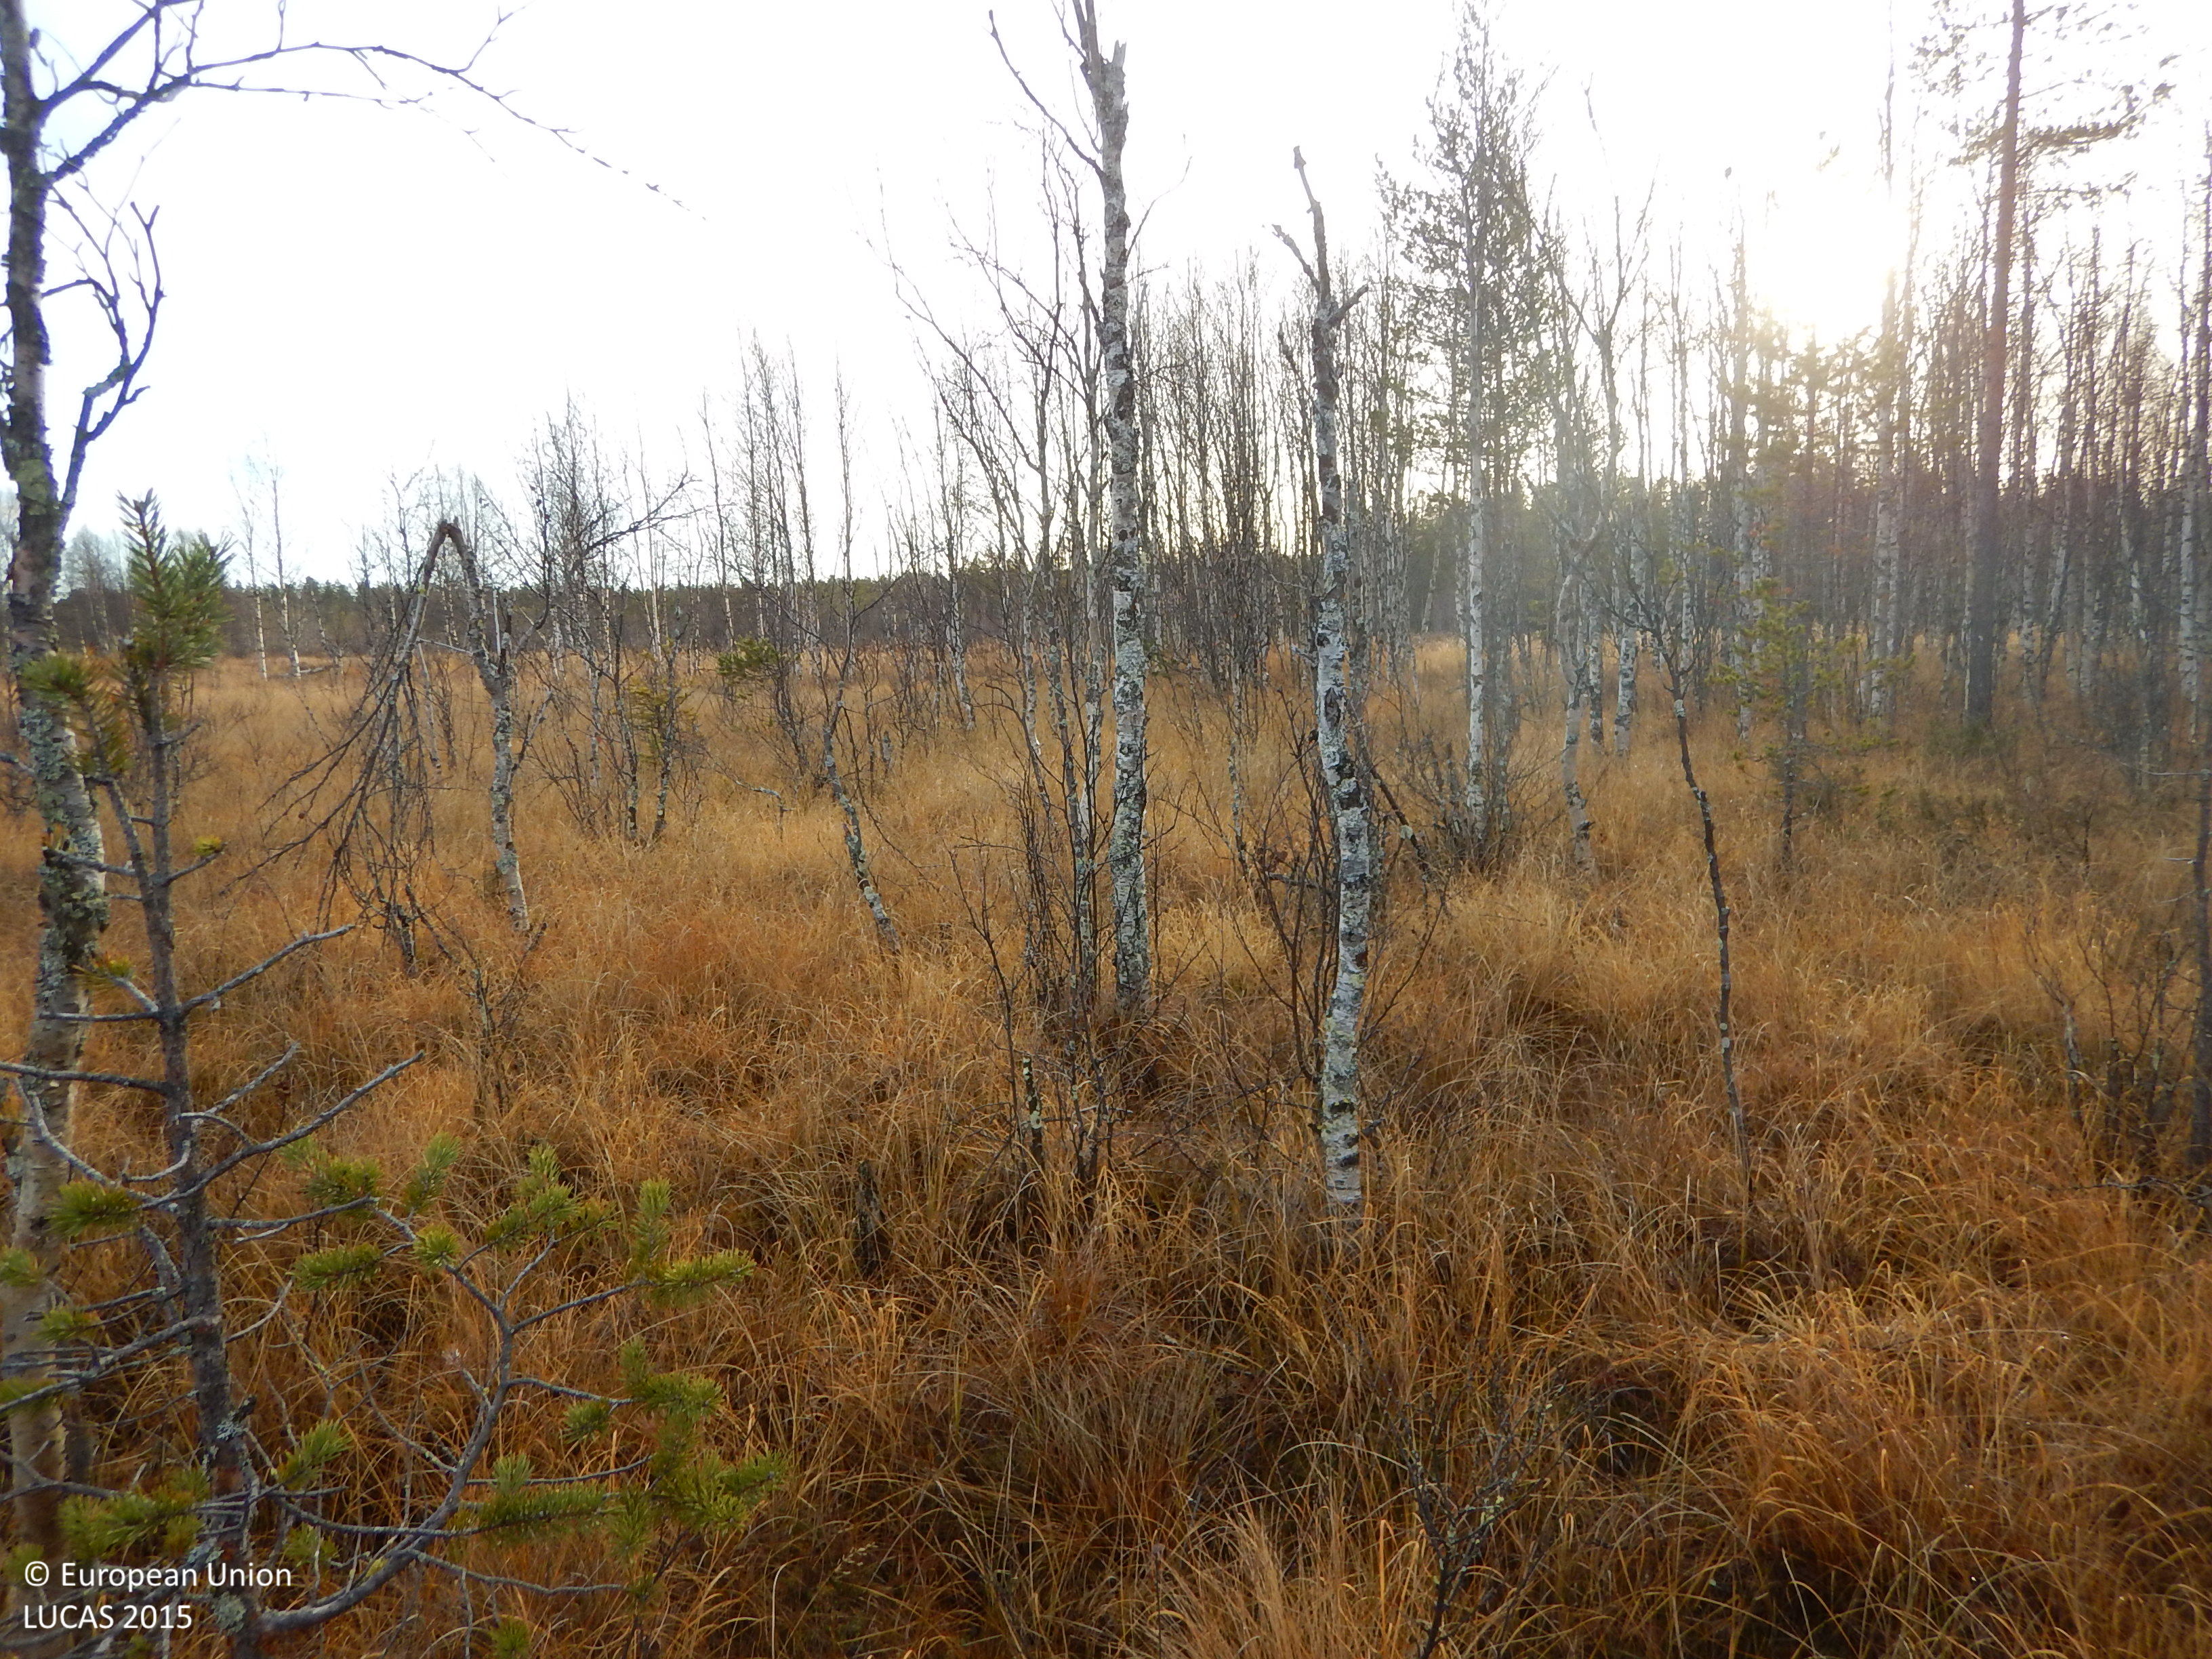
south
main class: Woodland
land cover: Pine dominated mixed woodland
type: mire and swamp forests
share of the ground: 10 - 25 %
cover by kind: herbaceous plants 60 %, coniferous forest trees 10 %, broadleaved forest trees 10 %, shrubs 10 %, lichens and mosses 10 %
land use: Semi-natural and natural areas not in use
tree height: > 5 m
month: October
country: SE
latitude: 65.3248
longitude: 20.2504
